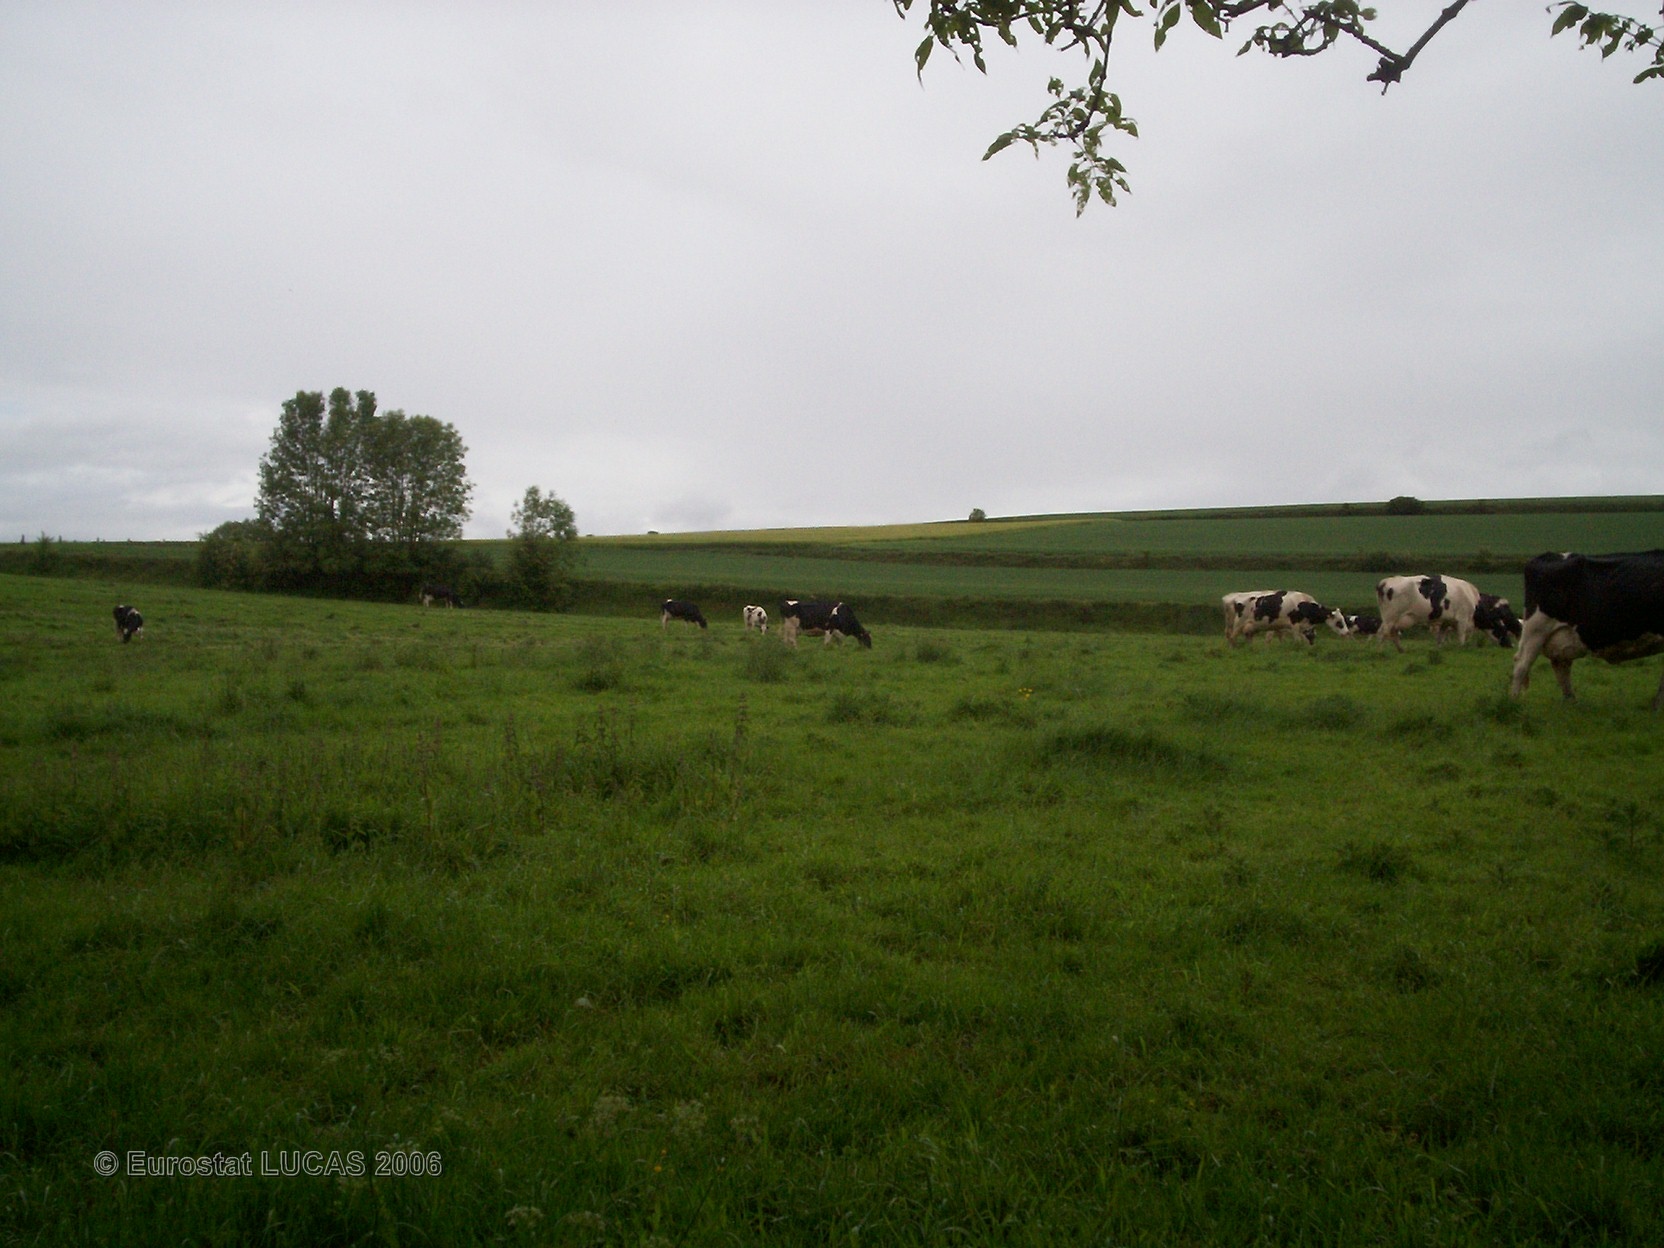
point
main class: Grassland
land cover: Grassland with sparse tree/shrub cover
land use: Agriculture (excluding fallow land and kitchen gardens)
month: May
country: FR
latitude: 50.4255
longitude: 2.5130
